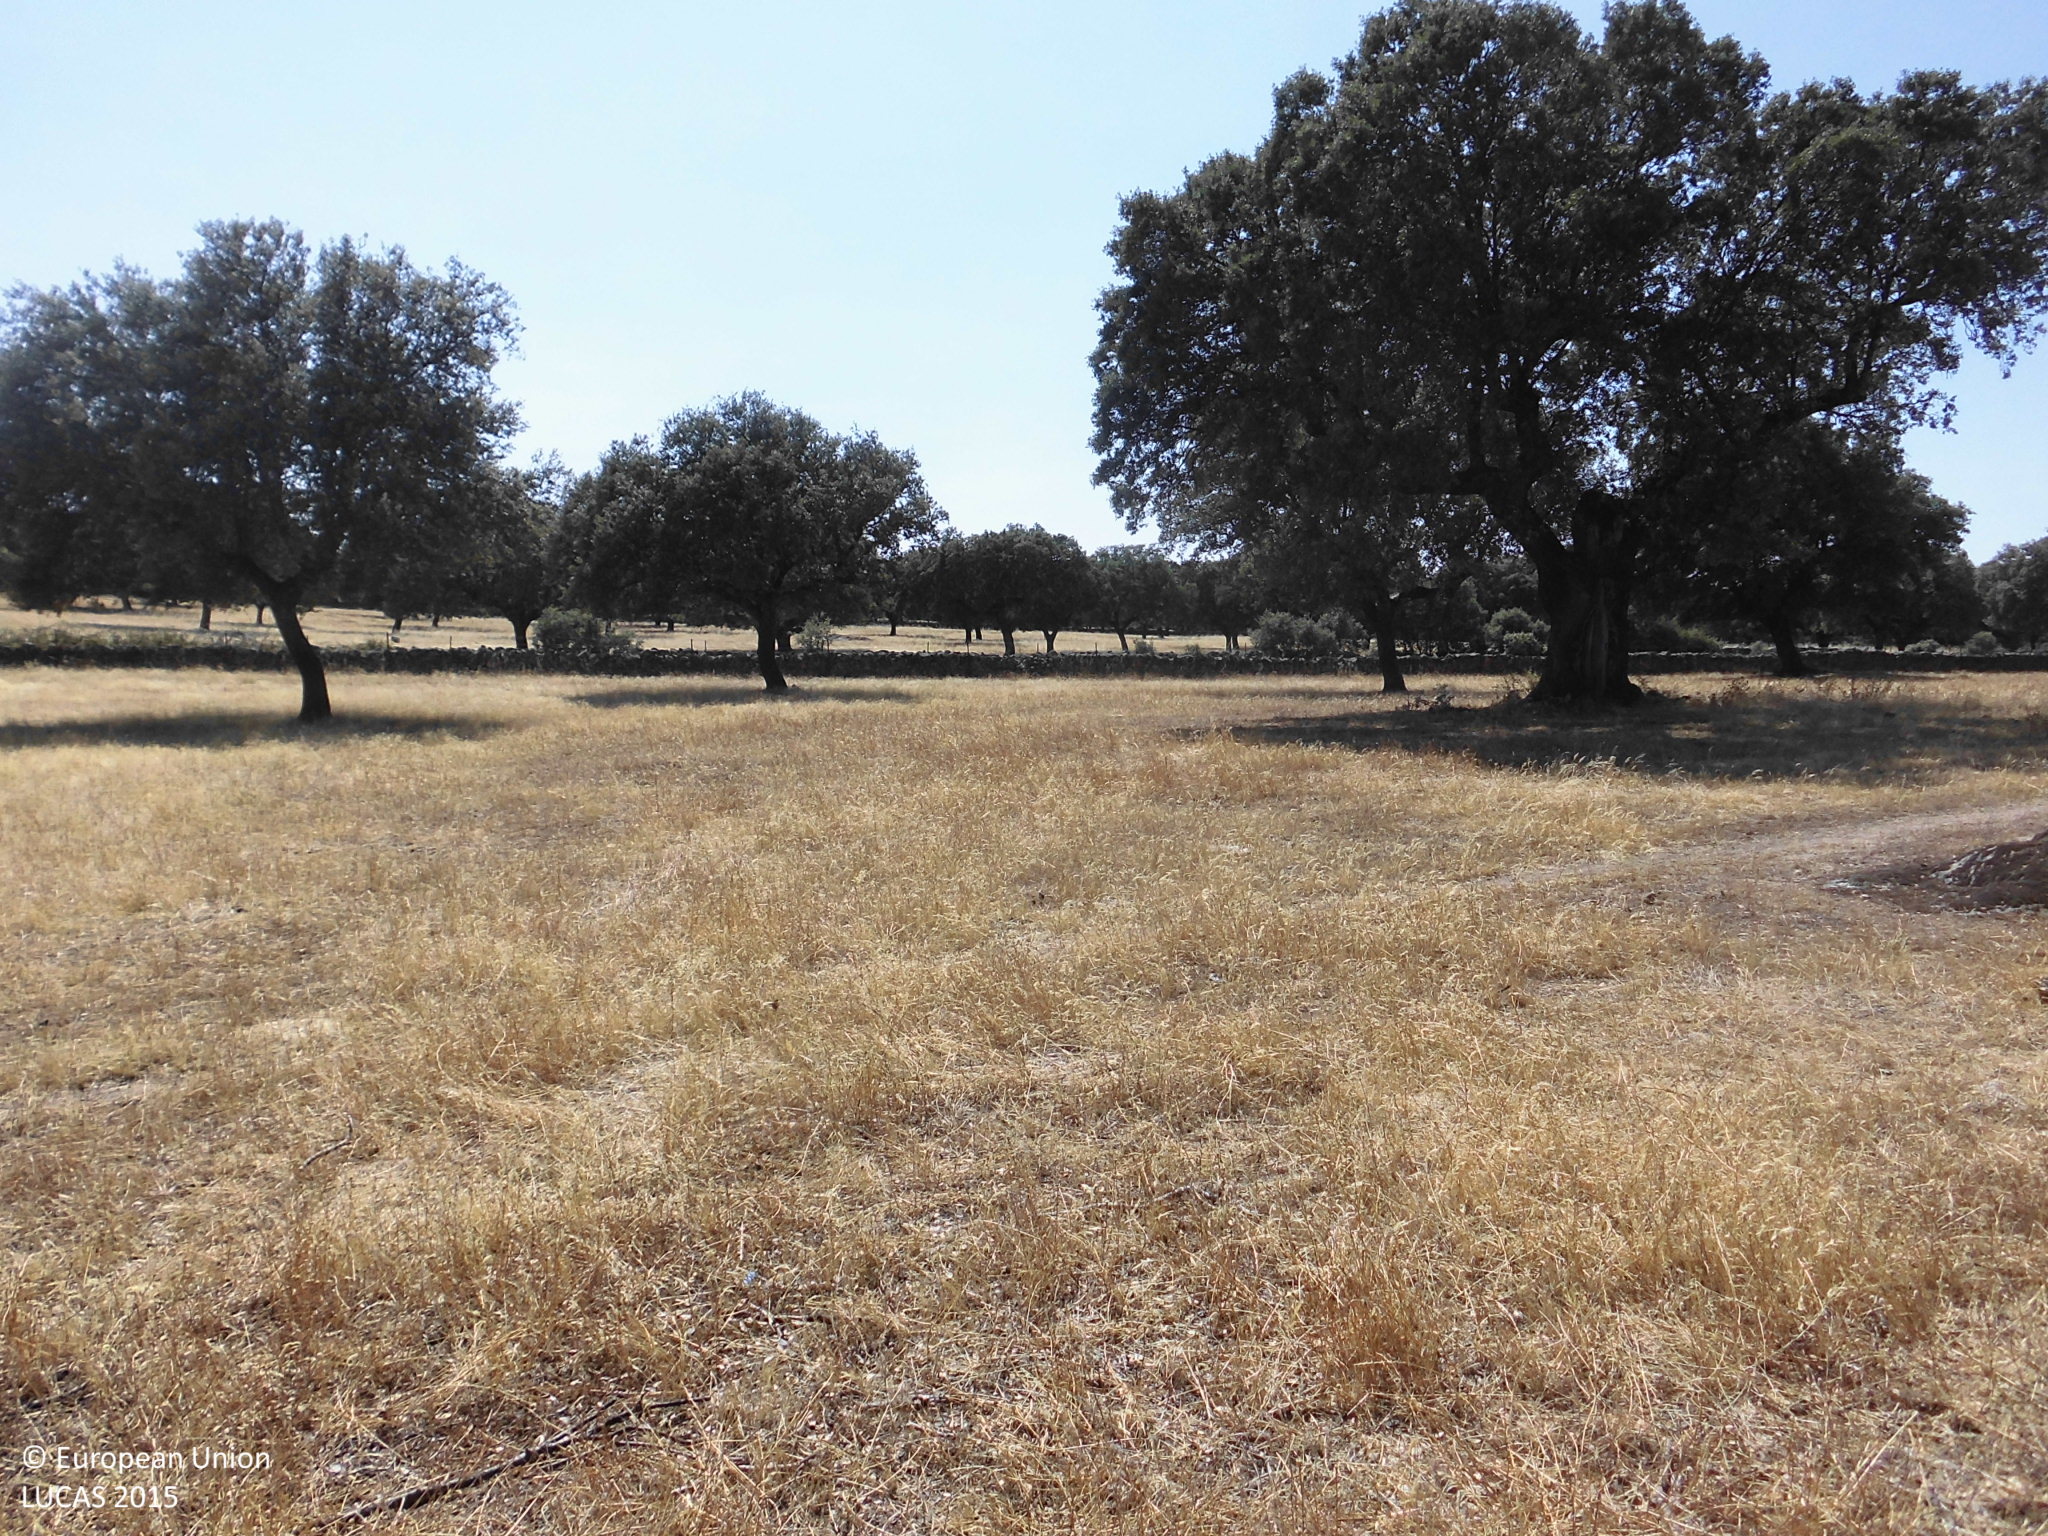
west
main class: Woodland
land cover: Broadleaved woodland
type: broadleaved evergreen forest
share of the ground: 25 - 50 %
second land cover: Grassland without tree/shrub cover
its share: > 75 %
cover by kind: herbaceous plants 70 %, broadleaved forest trees 30 %
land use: Forestry
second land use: Agriculture (excluding fallow land and kitchen gardens)
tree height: > 5 m
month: July
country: ES
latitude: 40.1609
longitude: -6.1000
